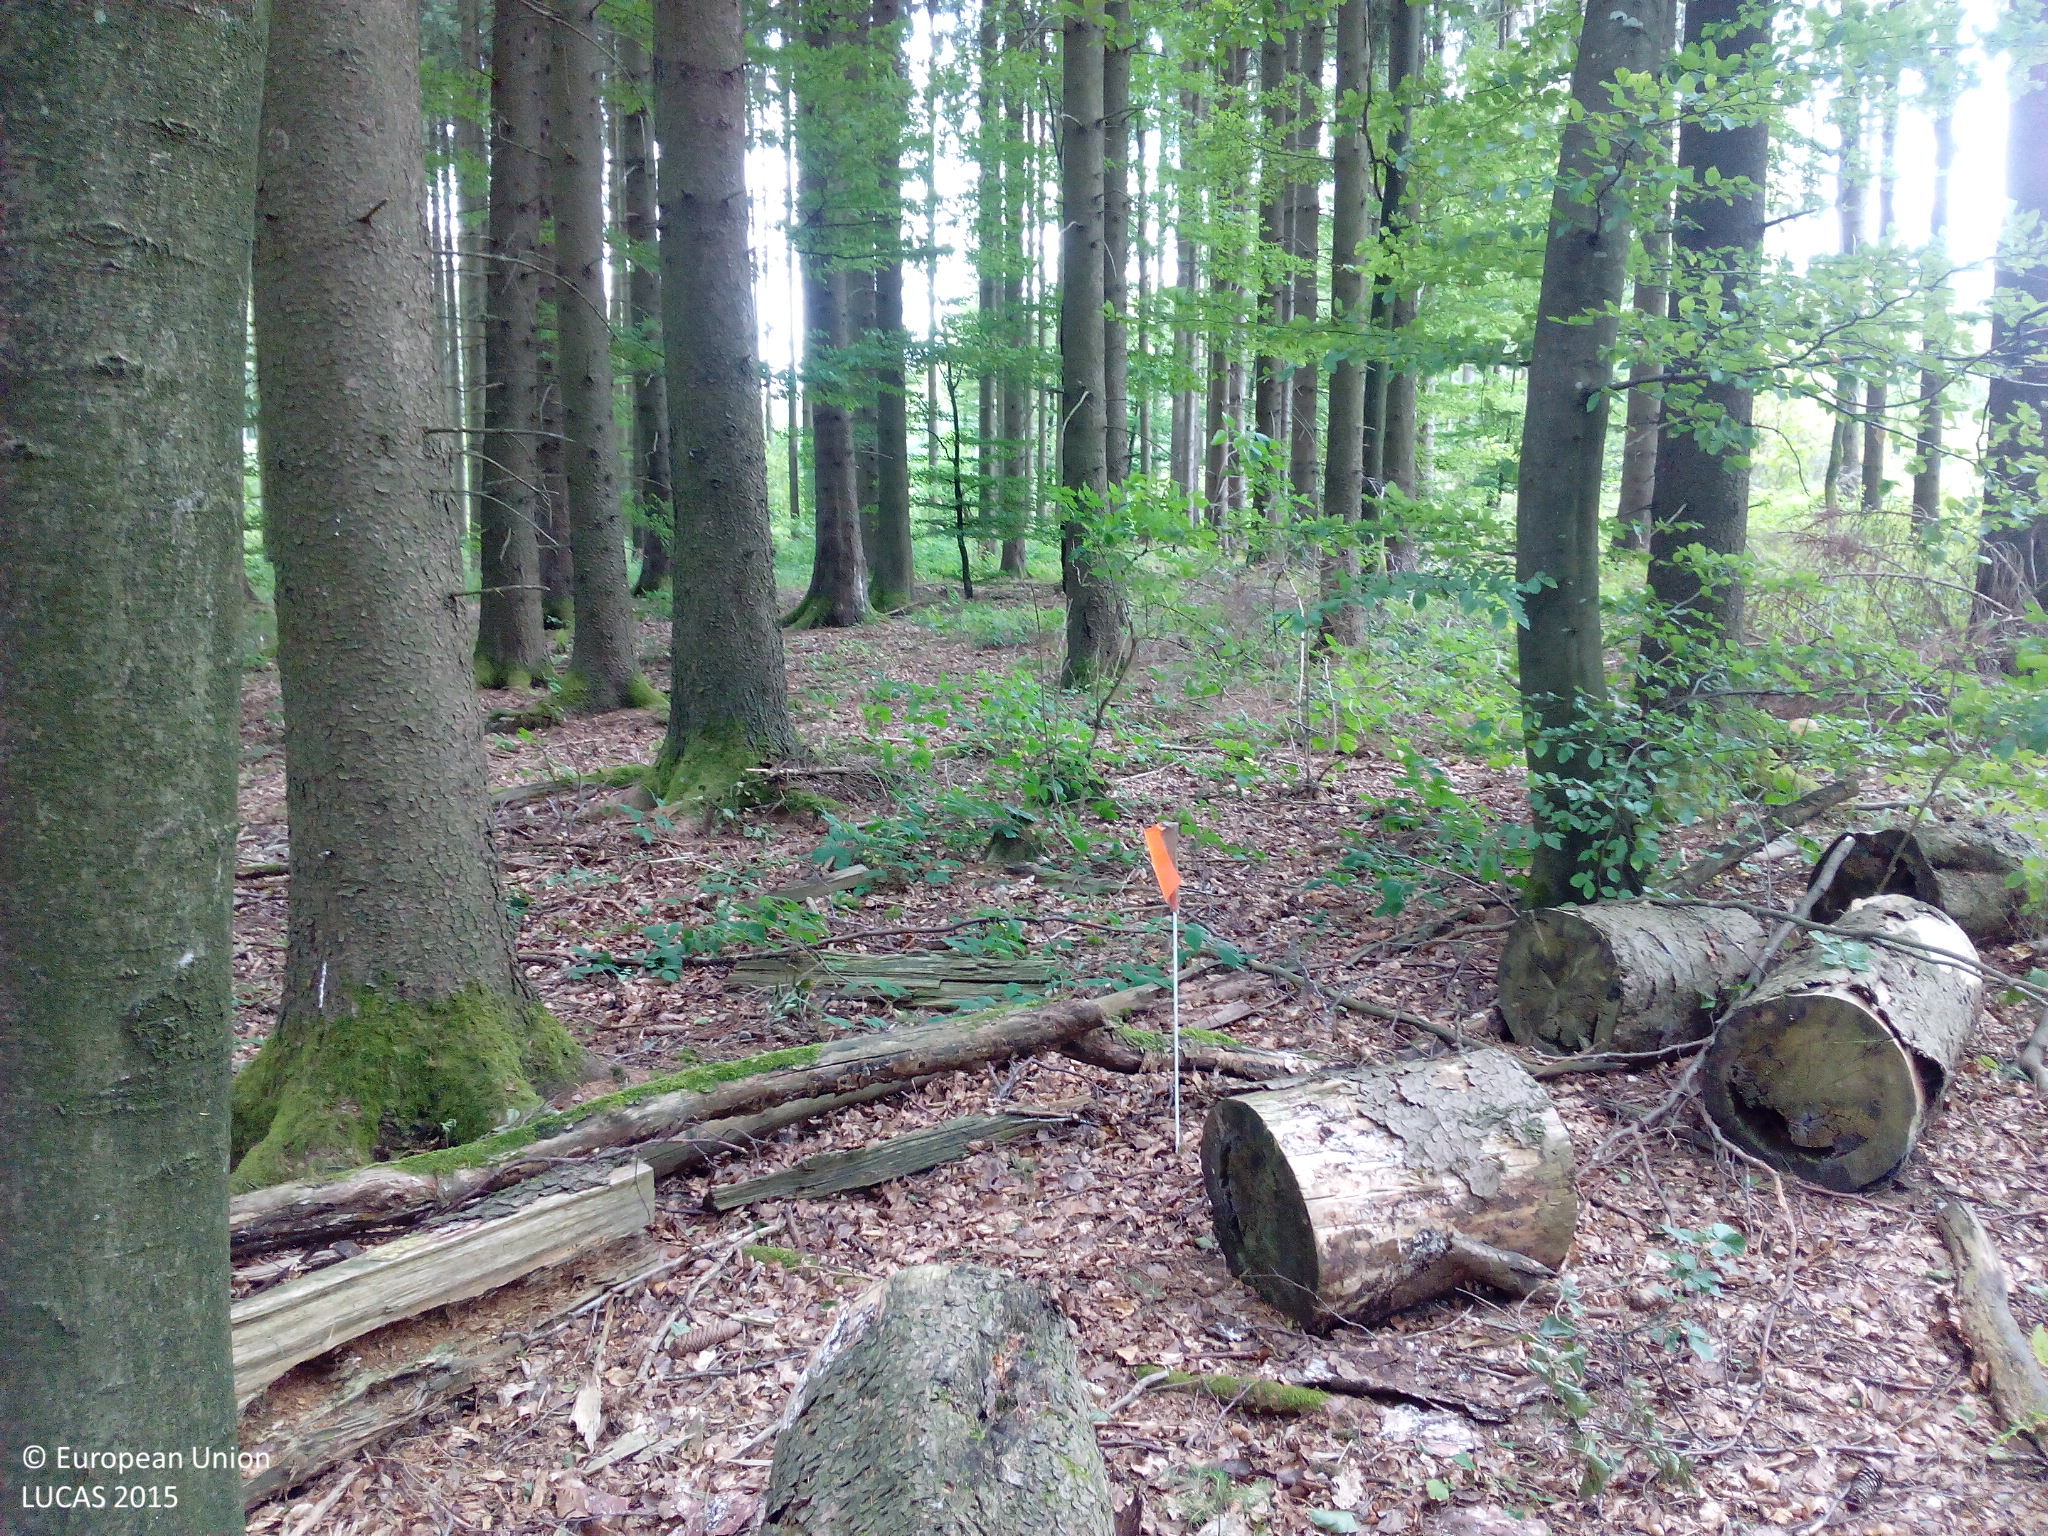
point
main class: Woodland
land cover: Spruce dominated mixed woodland
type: hemiboreal forest and nemoral coniferous forest and mixed broadleaved-coniferous forest
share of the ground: > 75 %
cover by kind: broadleaved forest trees 40 %, coniferous forest trees 35 %, unconsolidated bare surface 20 %, herbaceous plants 5 %
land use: Forestry
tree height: > 5 m
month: July
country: DE
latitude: 48.8170
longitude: 10.2586
